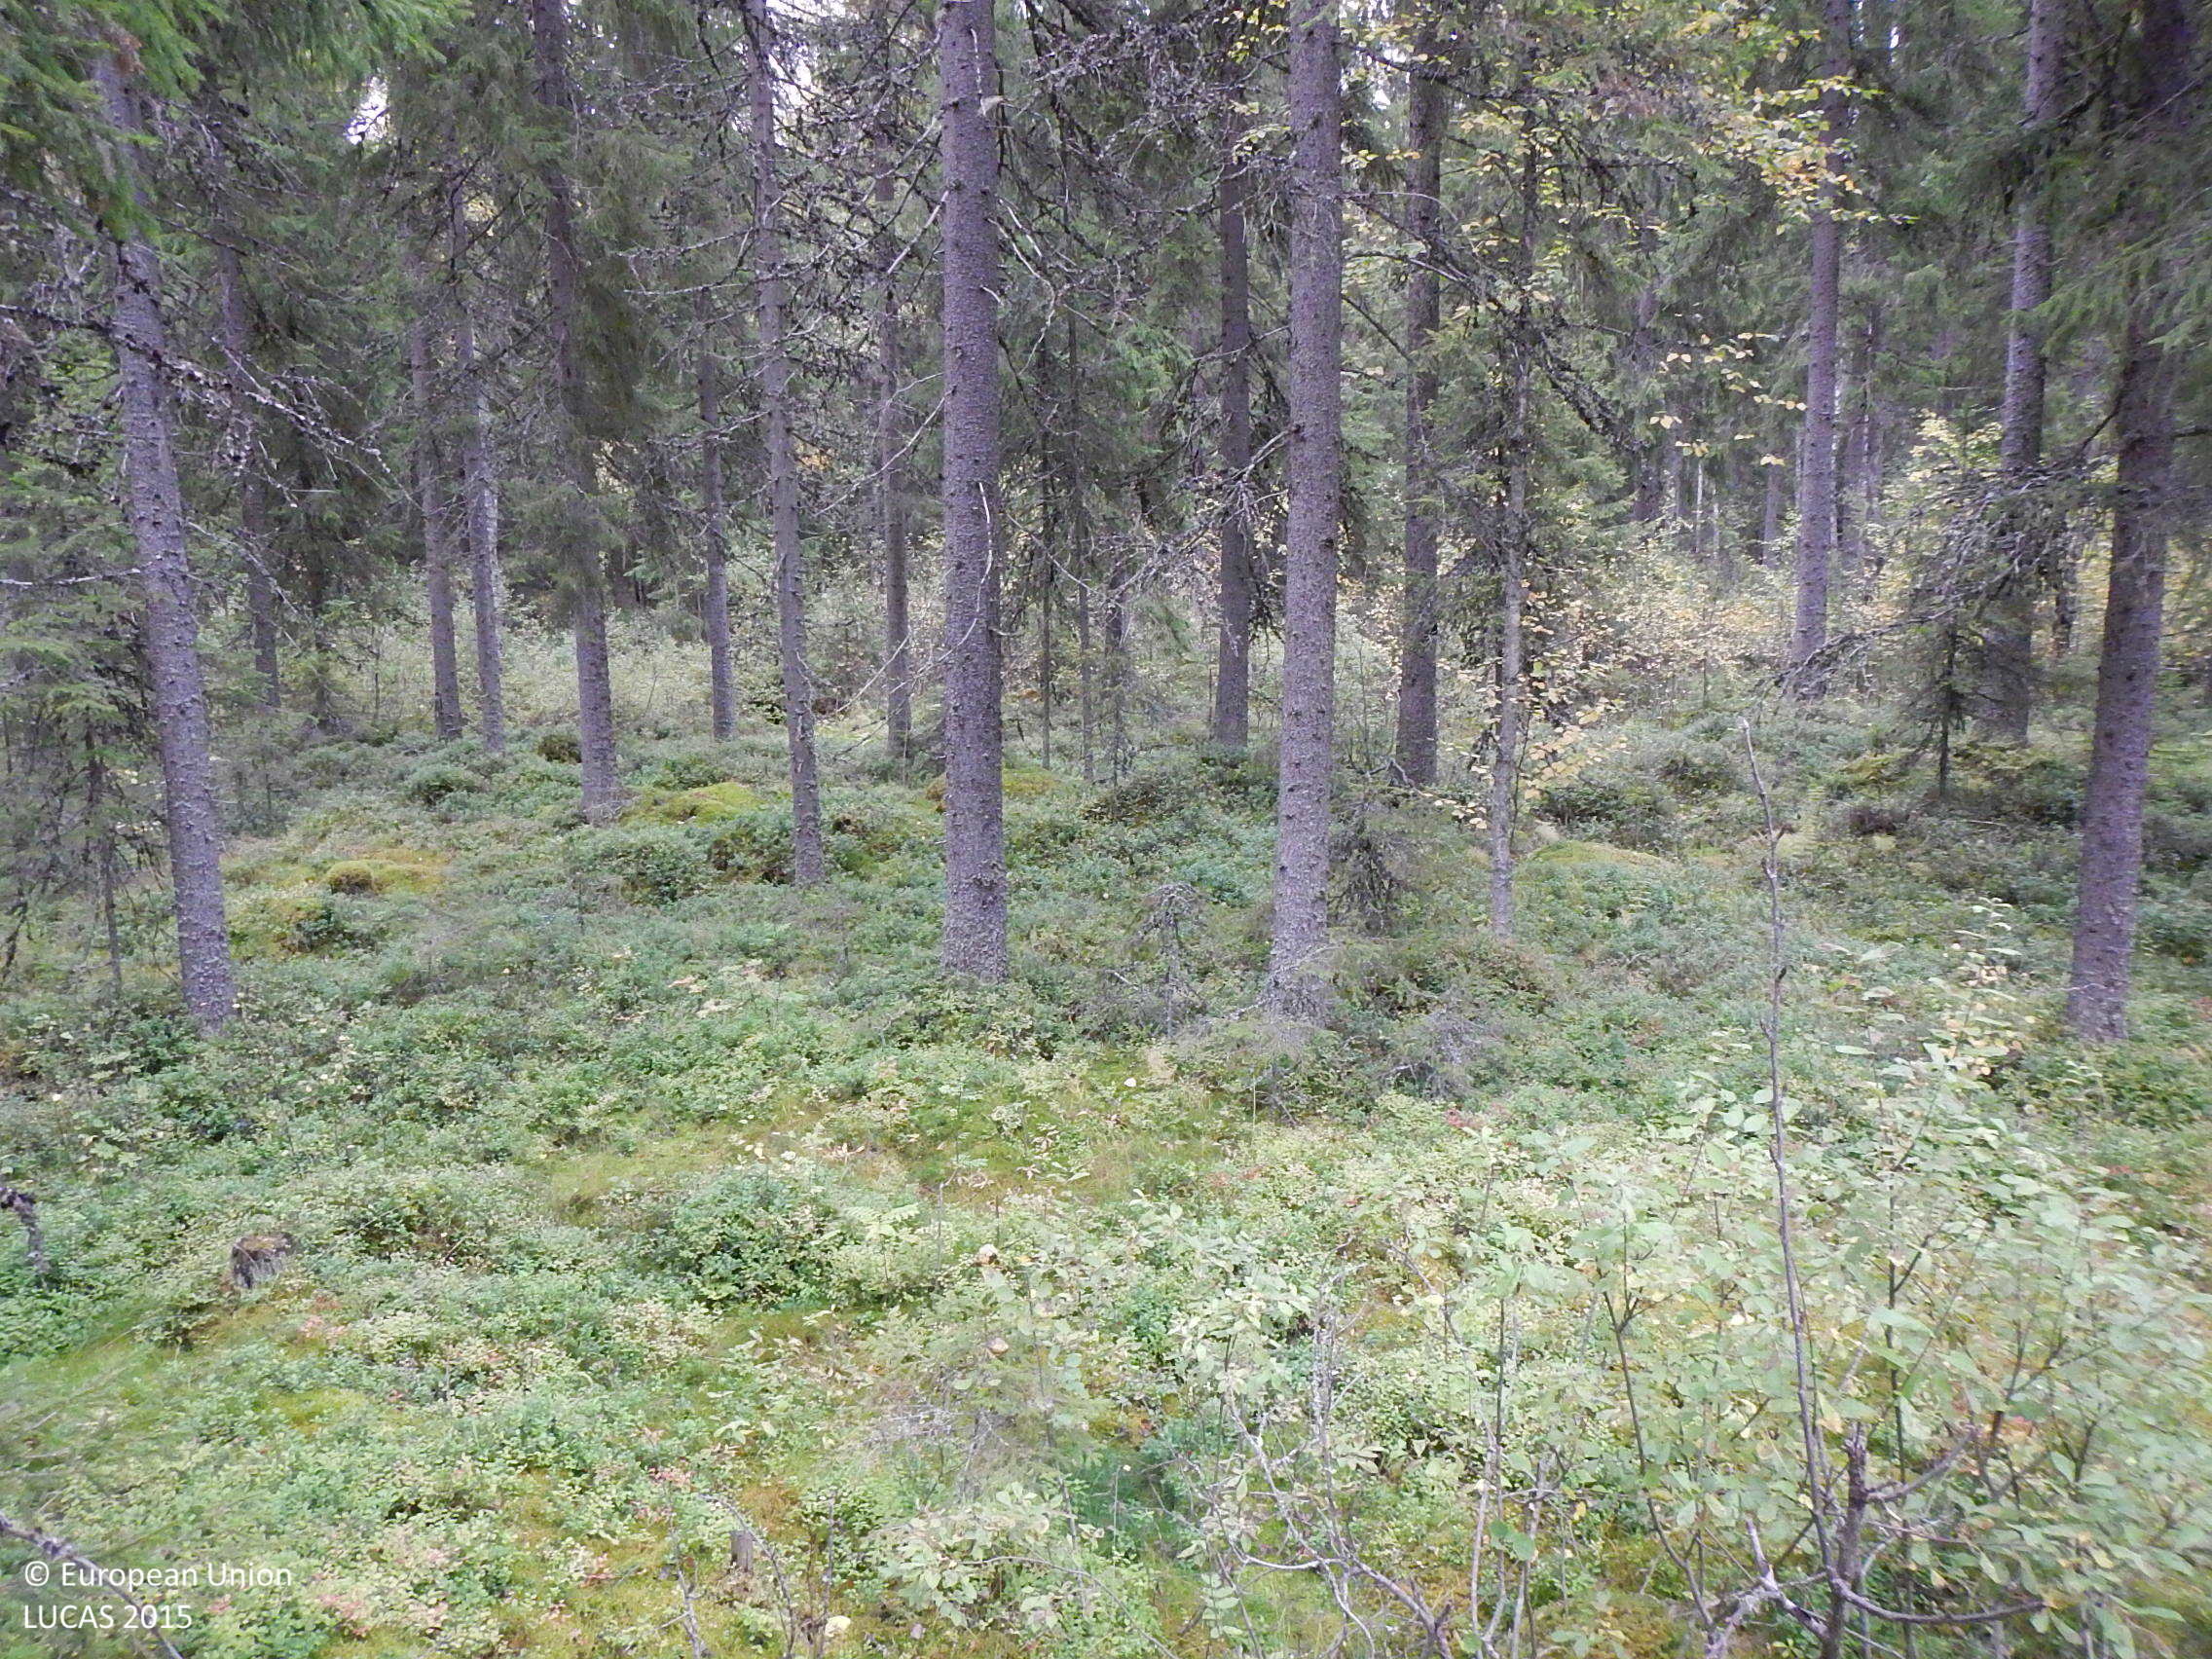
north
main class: Woodland
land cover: Spruce dominated coniferous woodland
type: boreal forest
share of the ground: 50 - 75 %
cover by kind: coniferous forest trees 40 %, shrubs 40 %, broadleaved forest trees 10 %, lichens and mosses 10 %
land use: Forestry
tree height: > 5 m
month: September
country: FI
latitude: 61.8426
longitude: 22.8117
